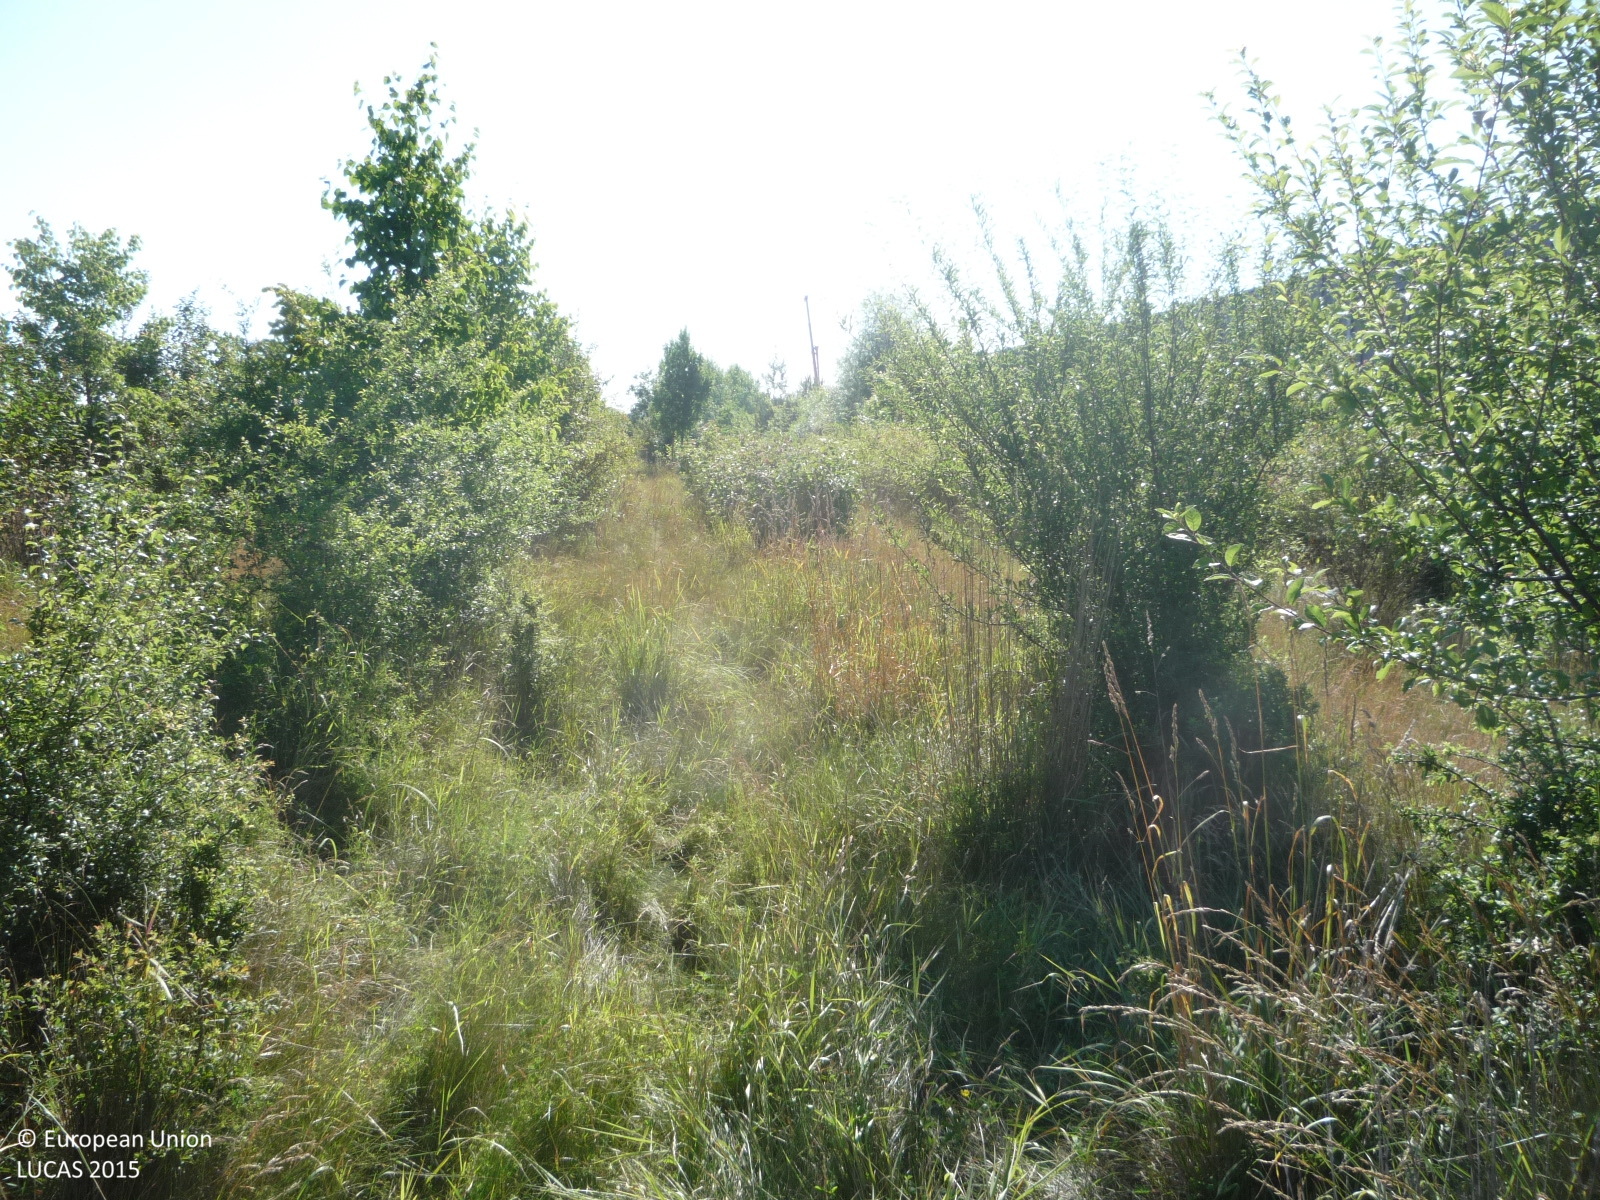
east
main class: Shrubland
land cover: Shrubland with sparse tree cover
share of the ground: > 75 %
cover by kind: shrubs 50 %, herbaceous plants 45 %, broadleaved forest trees 5 %
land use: Agriculture (excluding fallow land and kitchen gardens)
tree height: < 5 m
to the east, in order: Shrubland with sparse tree cover; Broadleaved woodland; Grassland with sparse tree/shrub cover; Artificial constructions; Paved roads, cycling and walking lanes
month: July
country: CZ
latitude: 50.1175
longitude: 15.2479
